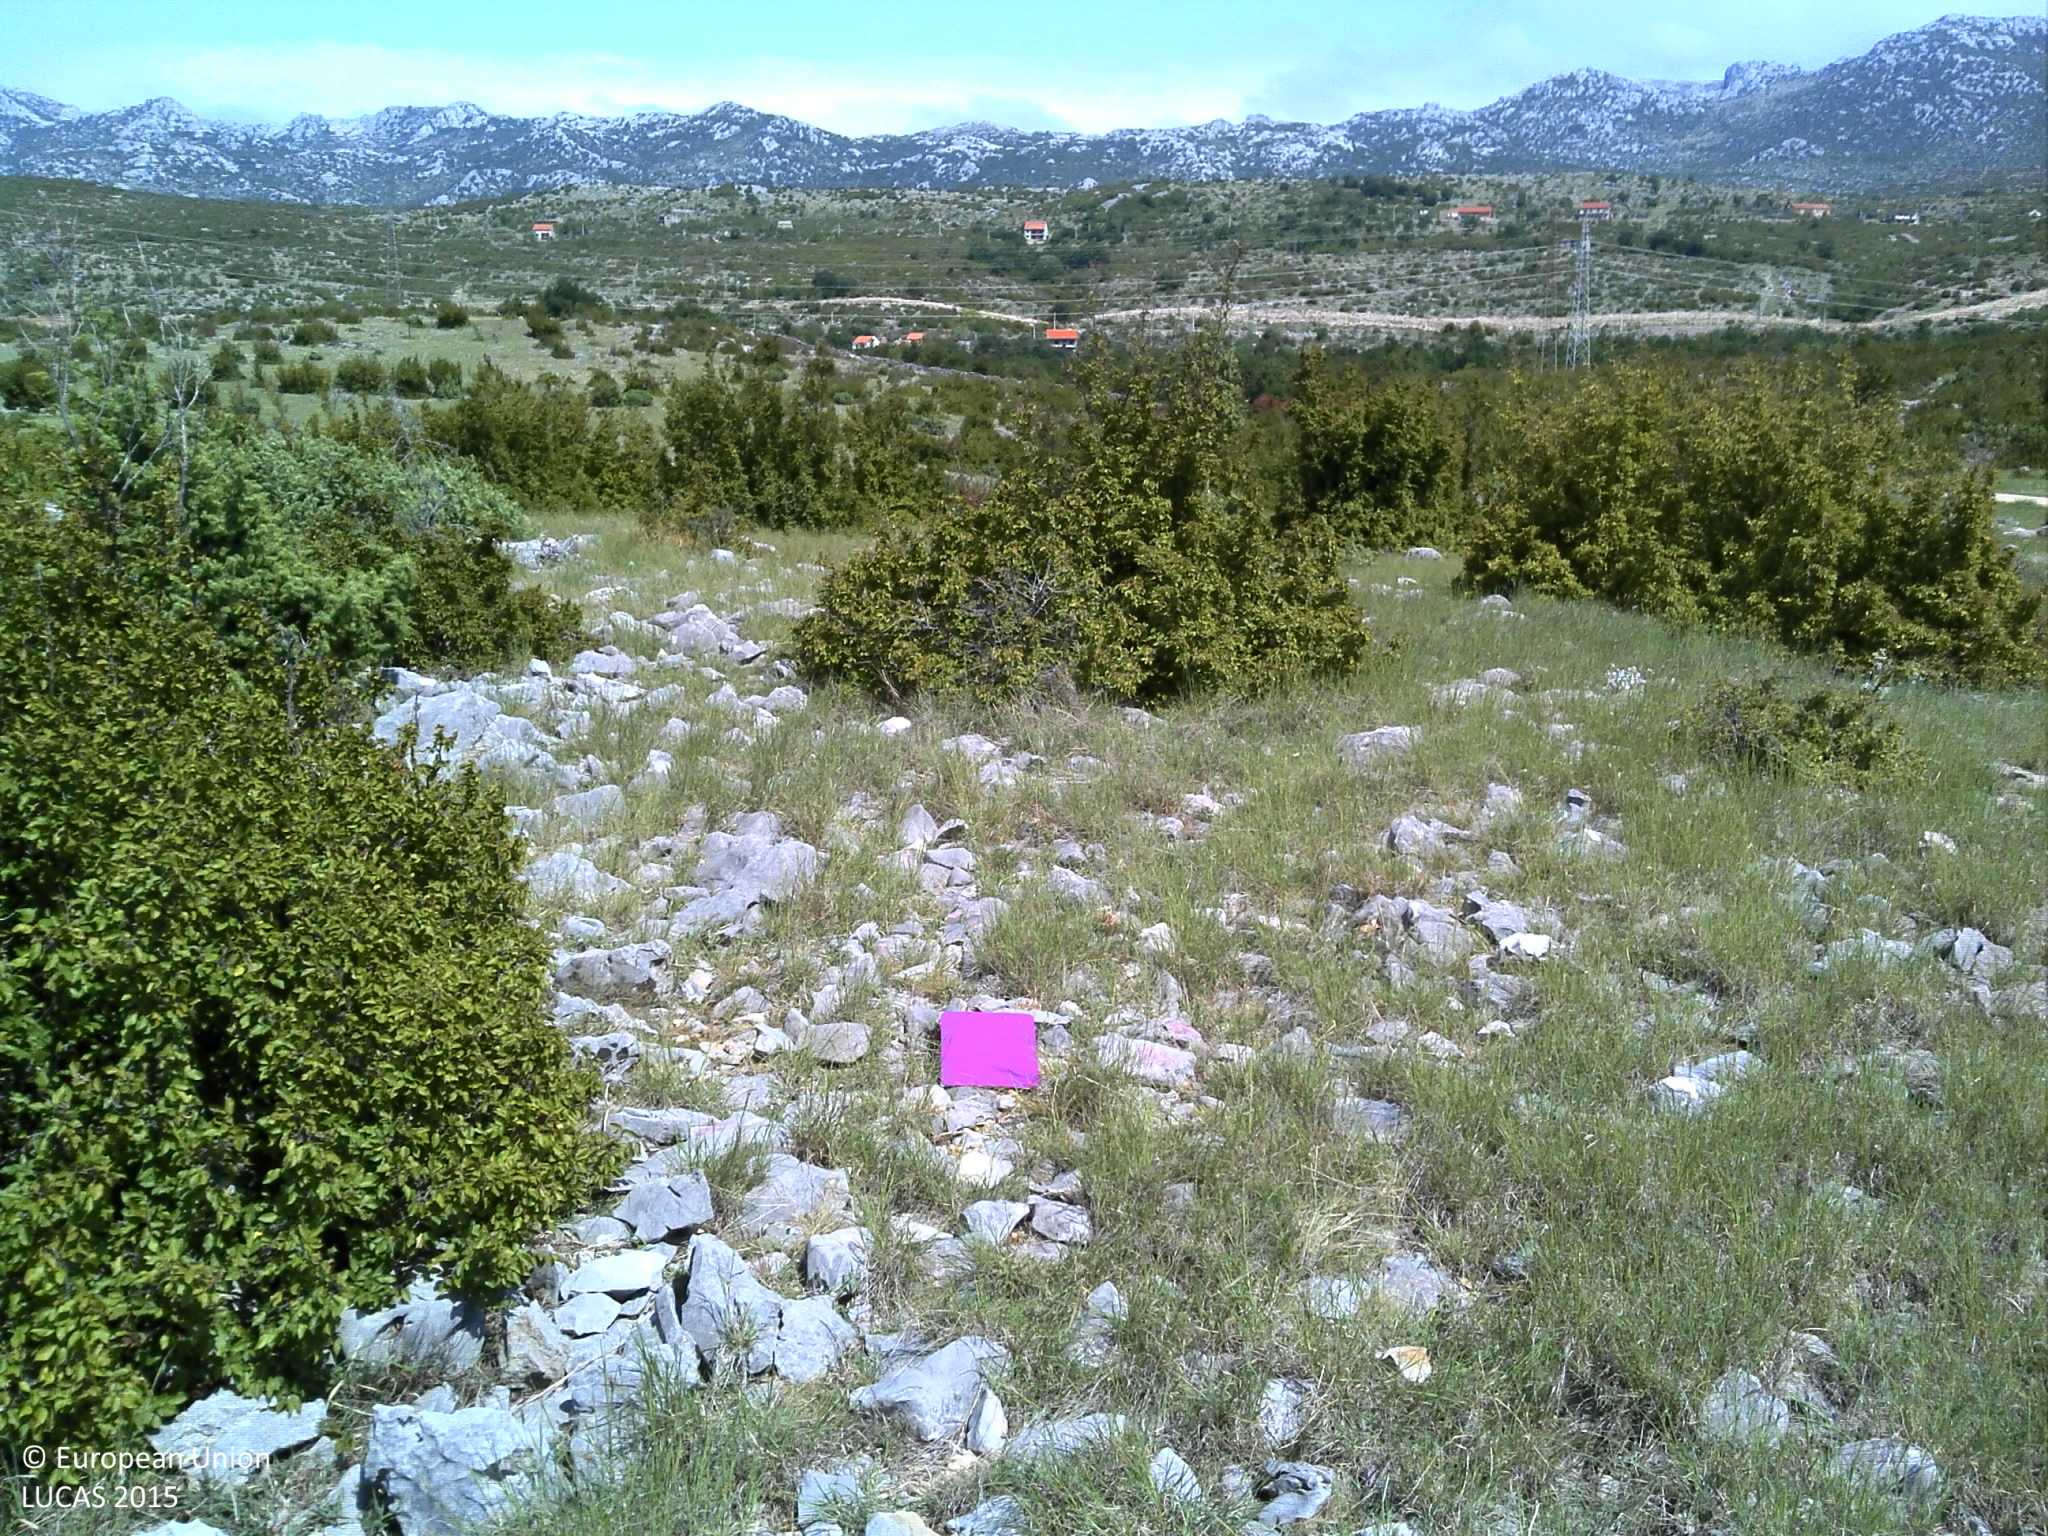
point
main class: Shrubland
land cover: Shrubland with sparse tree cover
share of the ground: > 75 %
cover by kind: shrubs 50 %, unconsolidated bare surface 25 %, herbaceous plants 20 %, broadleaved forest trees 5 %
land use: Semi-natural and natural areas not in use
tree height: < 5 m
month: August
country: HR
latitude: 44.2113
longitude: 15.7121
